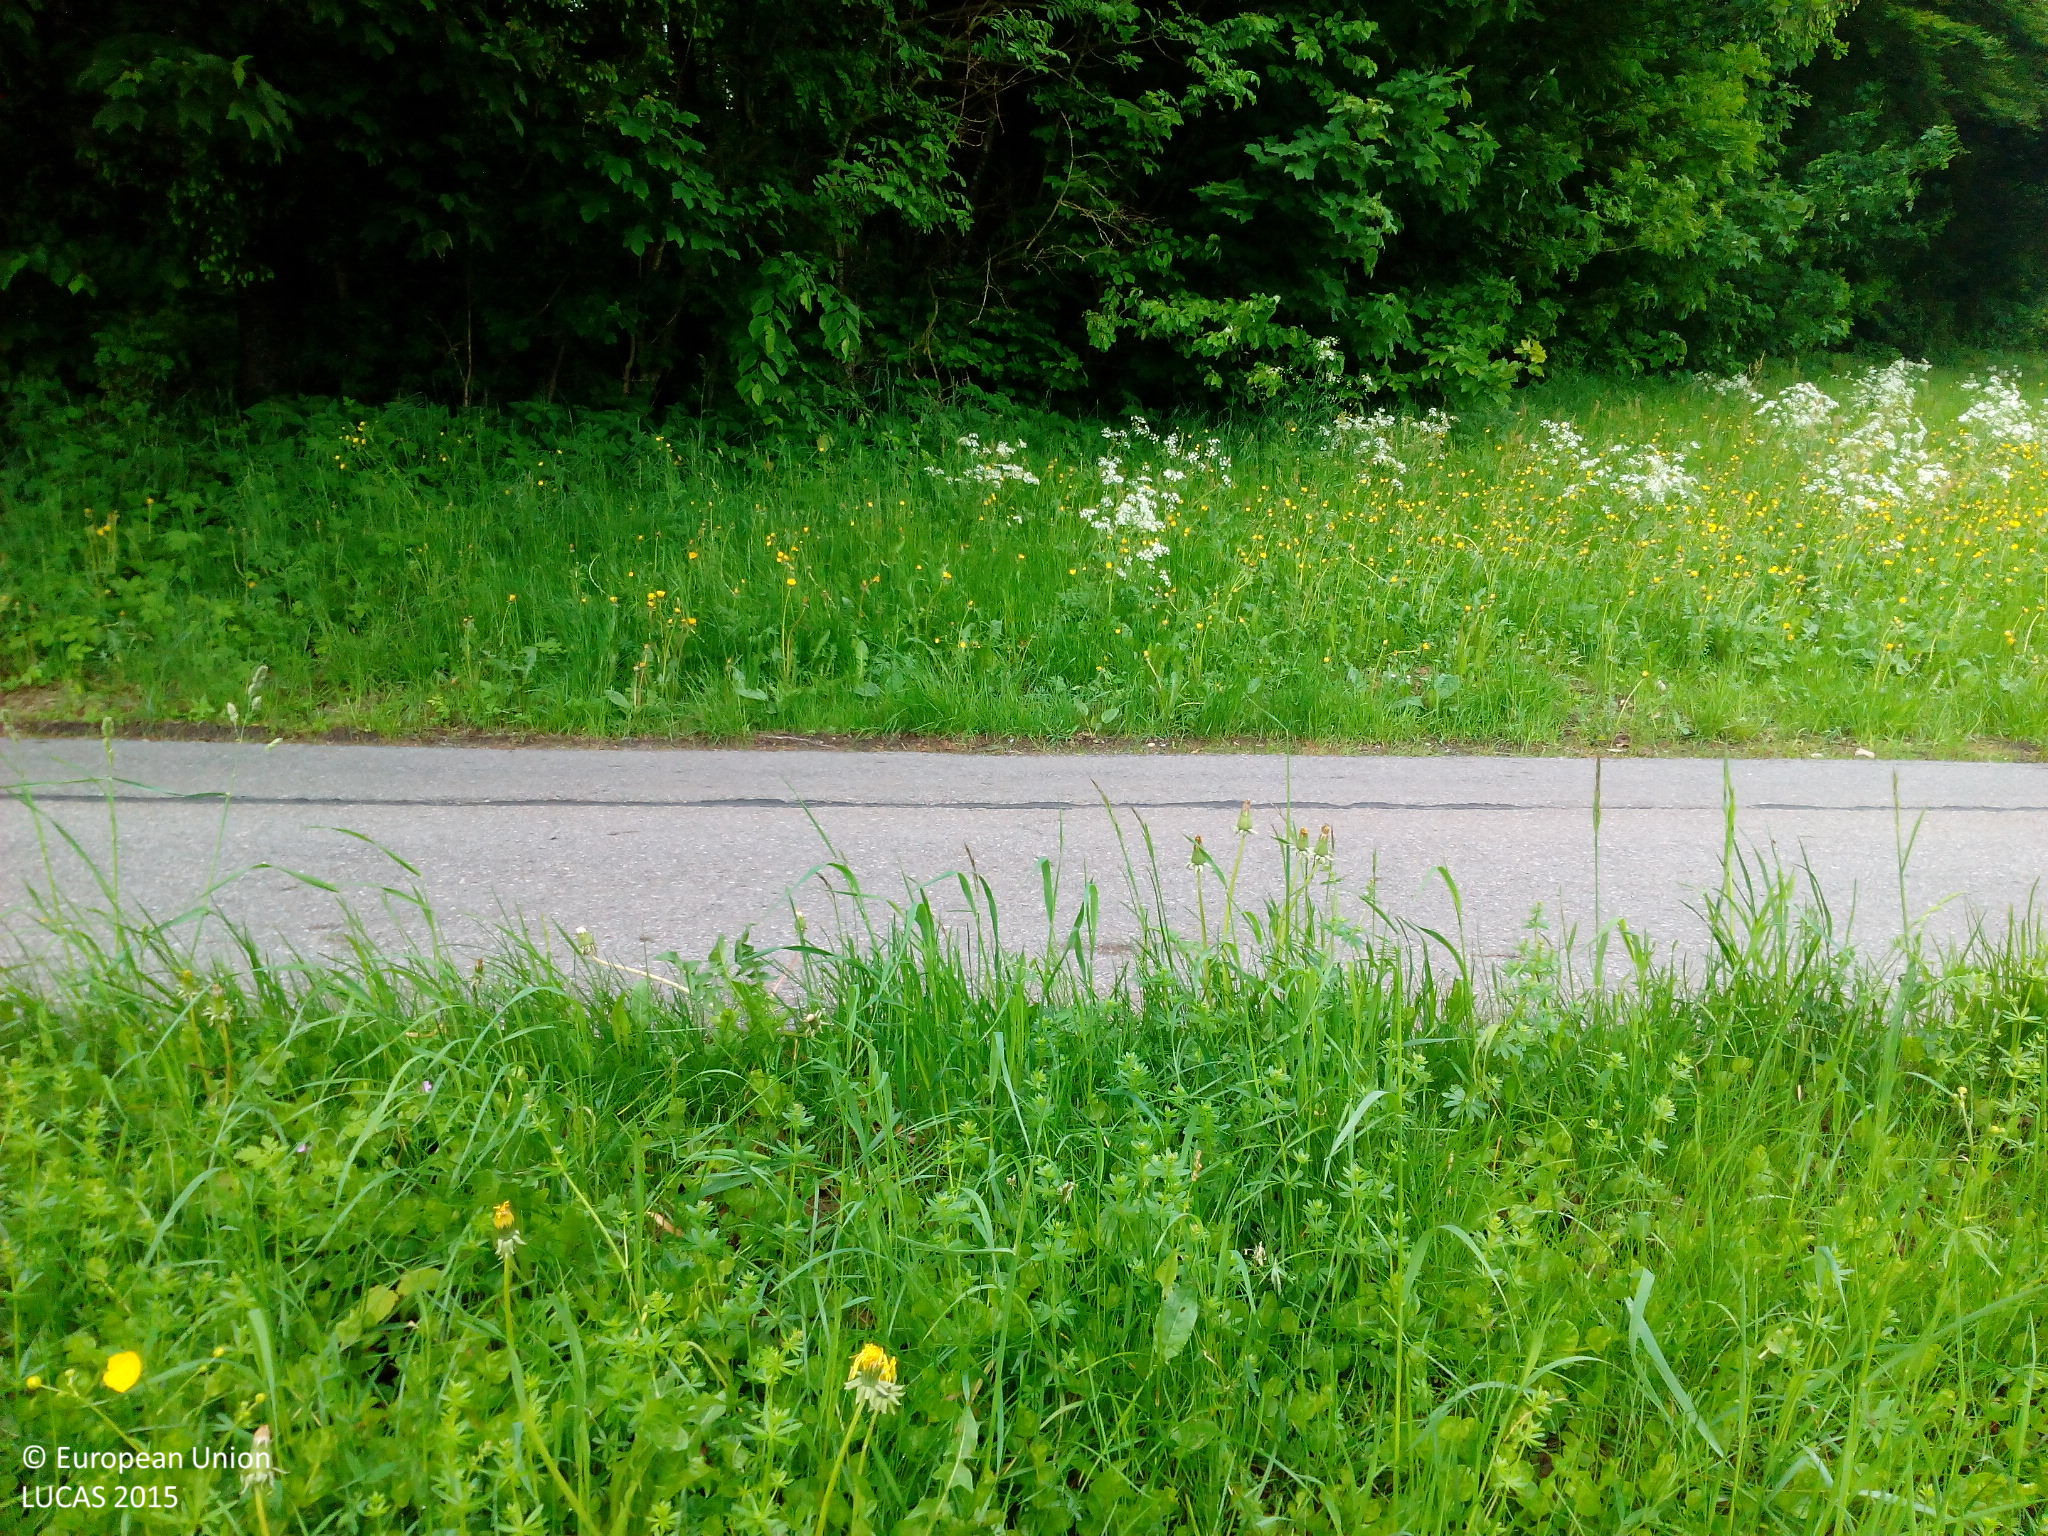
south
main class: Grassland
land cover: Grassland without tree/shrub cover
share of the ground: > 75 %
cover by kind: herbaceous plants 100 %
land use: Agriculture (excluding fallow land and kitchen gardens)
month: May
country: DE
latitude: 47.8275
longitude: 9.8532
